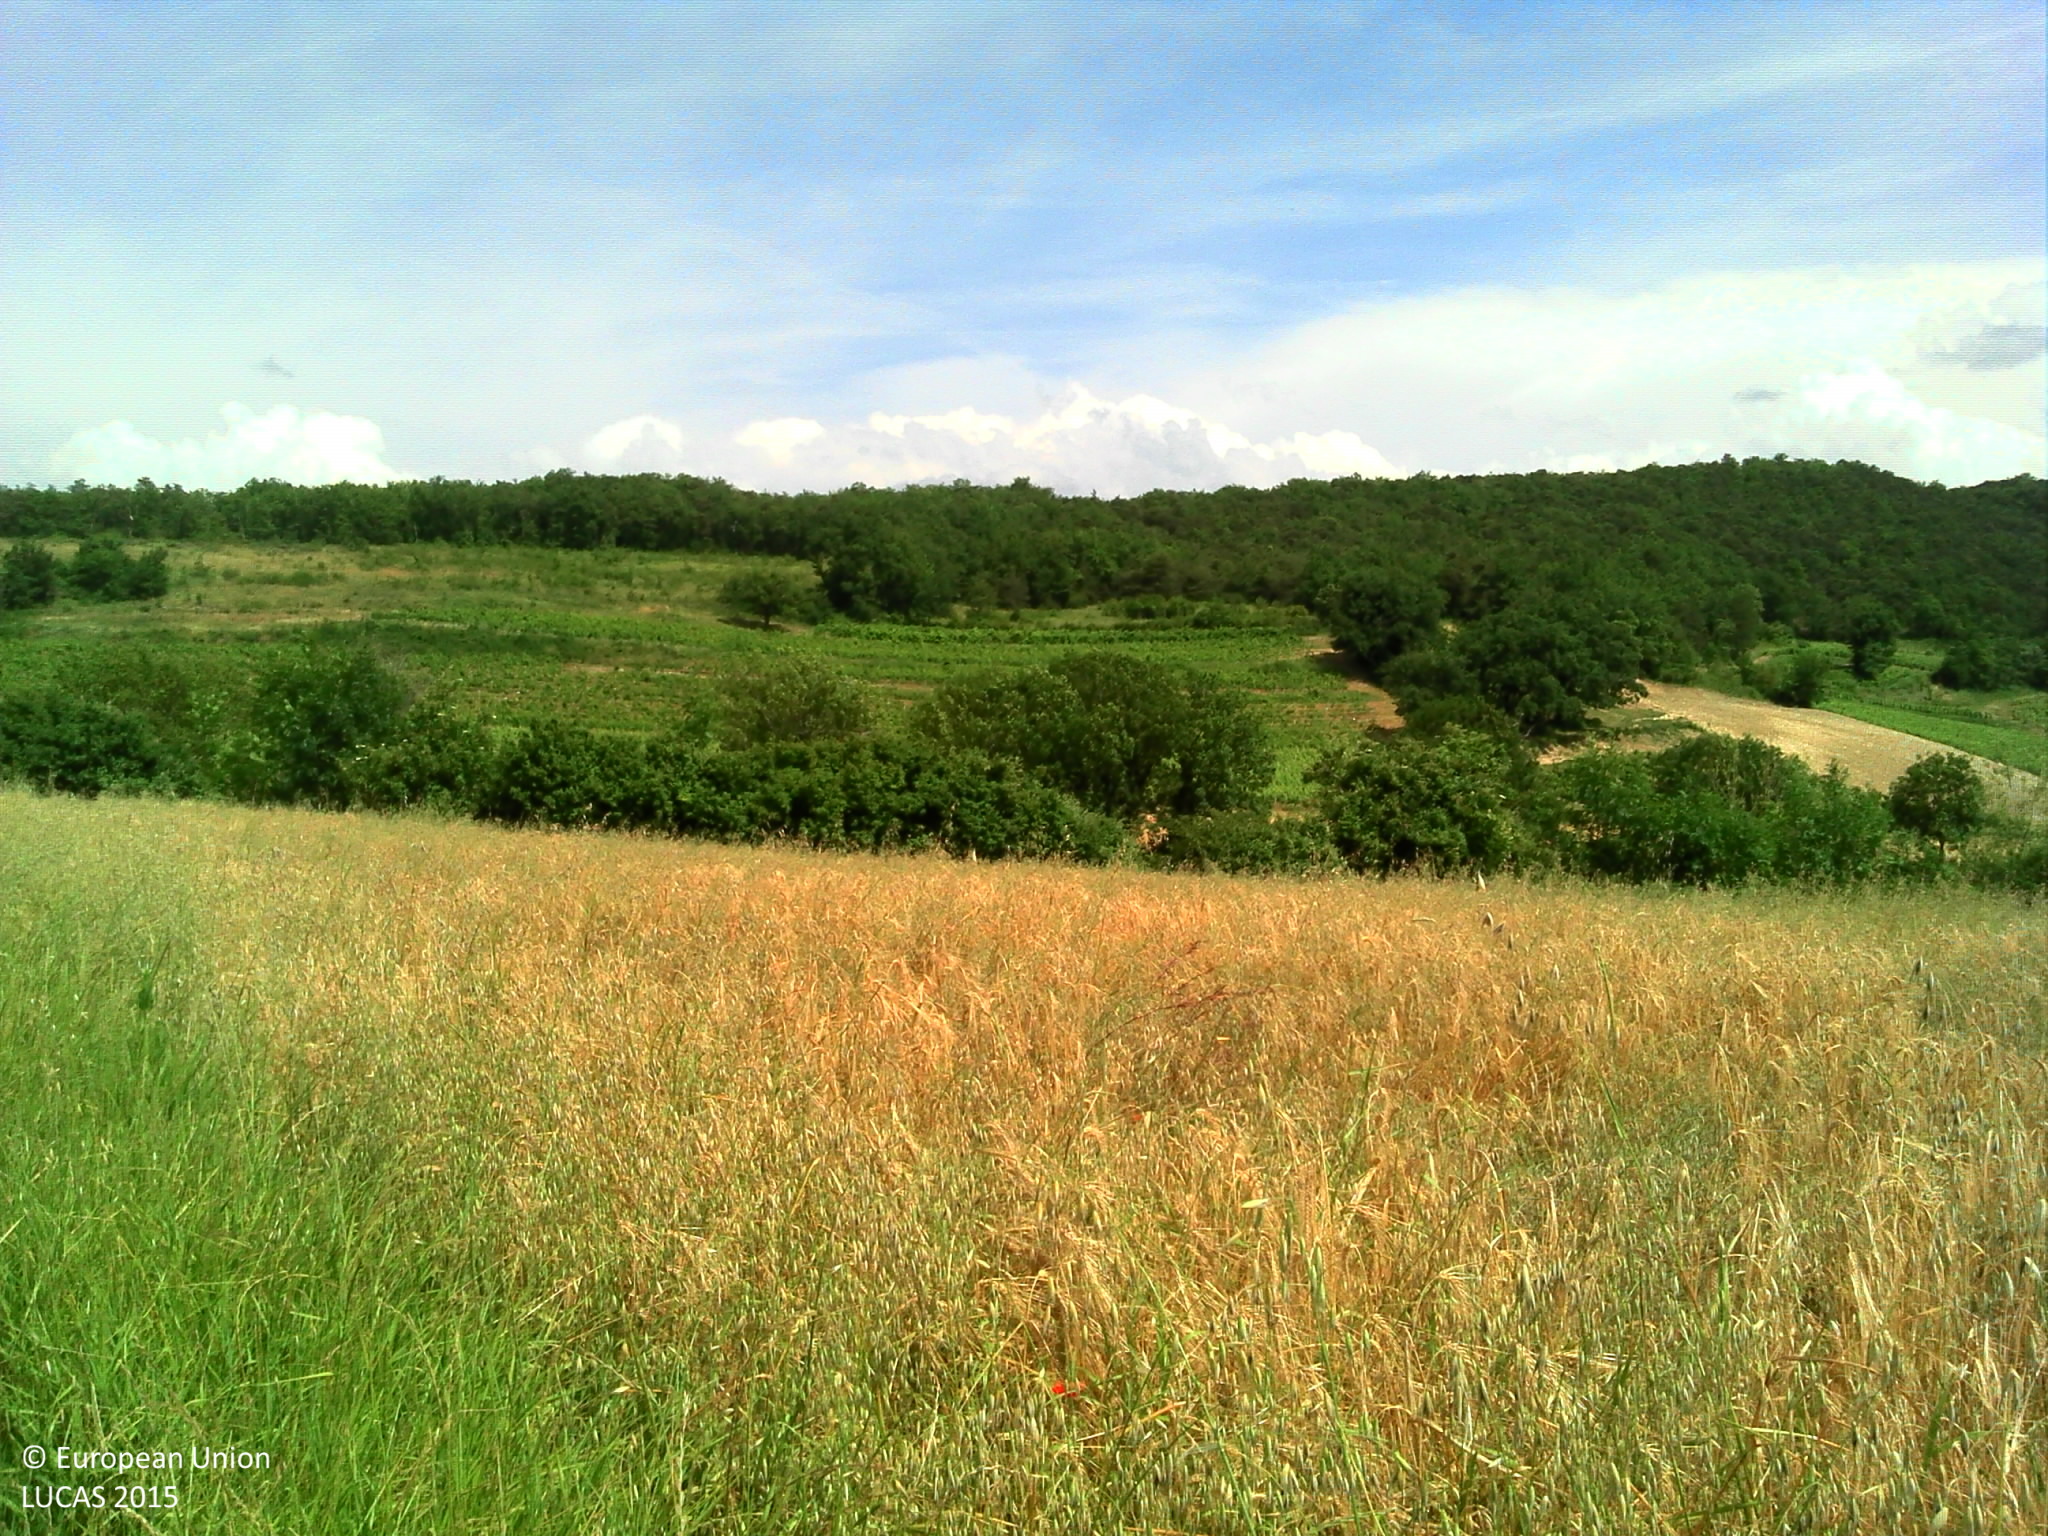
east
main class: Cropland
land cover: Temporary grasslands
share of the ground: > 75 %
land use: Agriculture (excluding fallow land and kitchen gardens)
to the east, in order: Temporary grasslands; Abandoned hedges; Barley; Lines of trees; Barley; Tracks; Vineyards
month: June
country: FR
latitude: 44.7595
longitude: 5.1173
